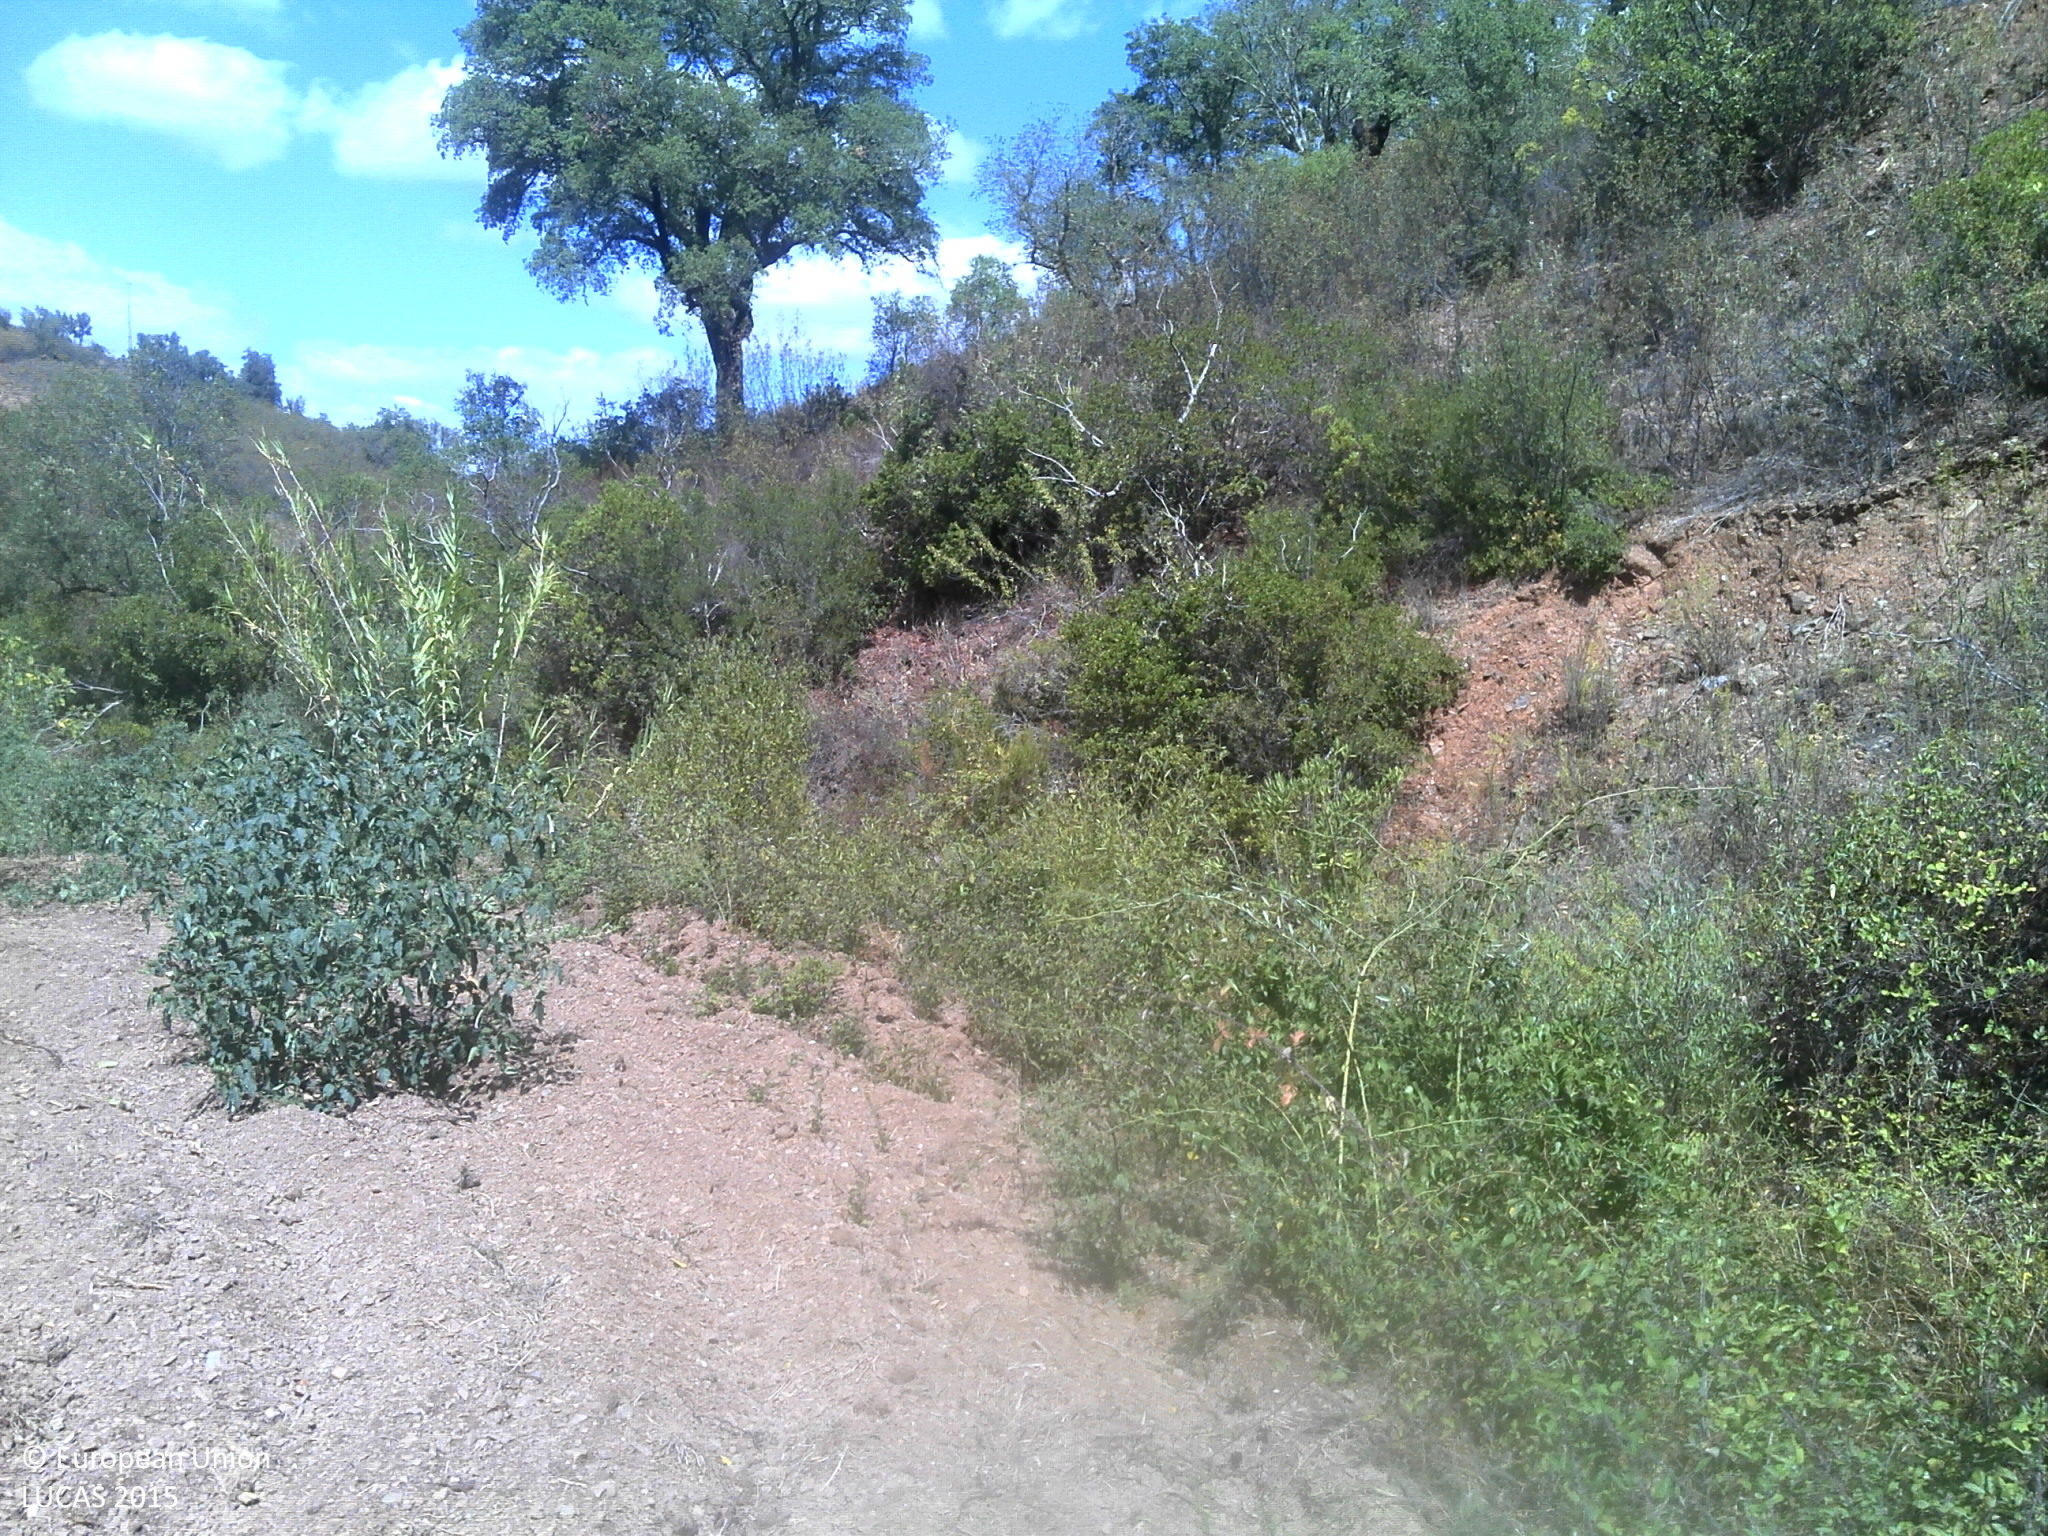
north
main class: Shrubland
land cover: Shrubland with sparse tree cover
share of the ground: > 75 %
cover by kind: shrubs 75 %, unconsolidated bare surface 20 %, broadleaved forest trees 5 %
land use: Abandoned areas
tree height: < 5 m
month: September
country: PT
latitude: 37.3093
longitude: -8.1977
